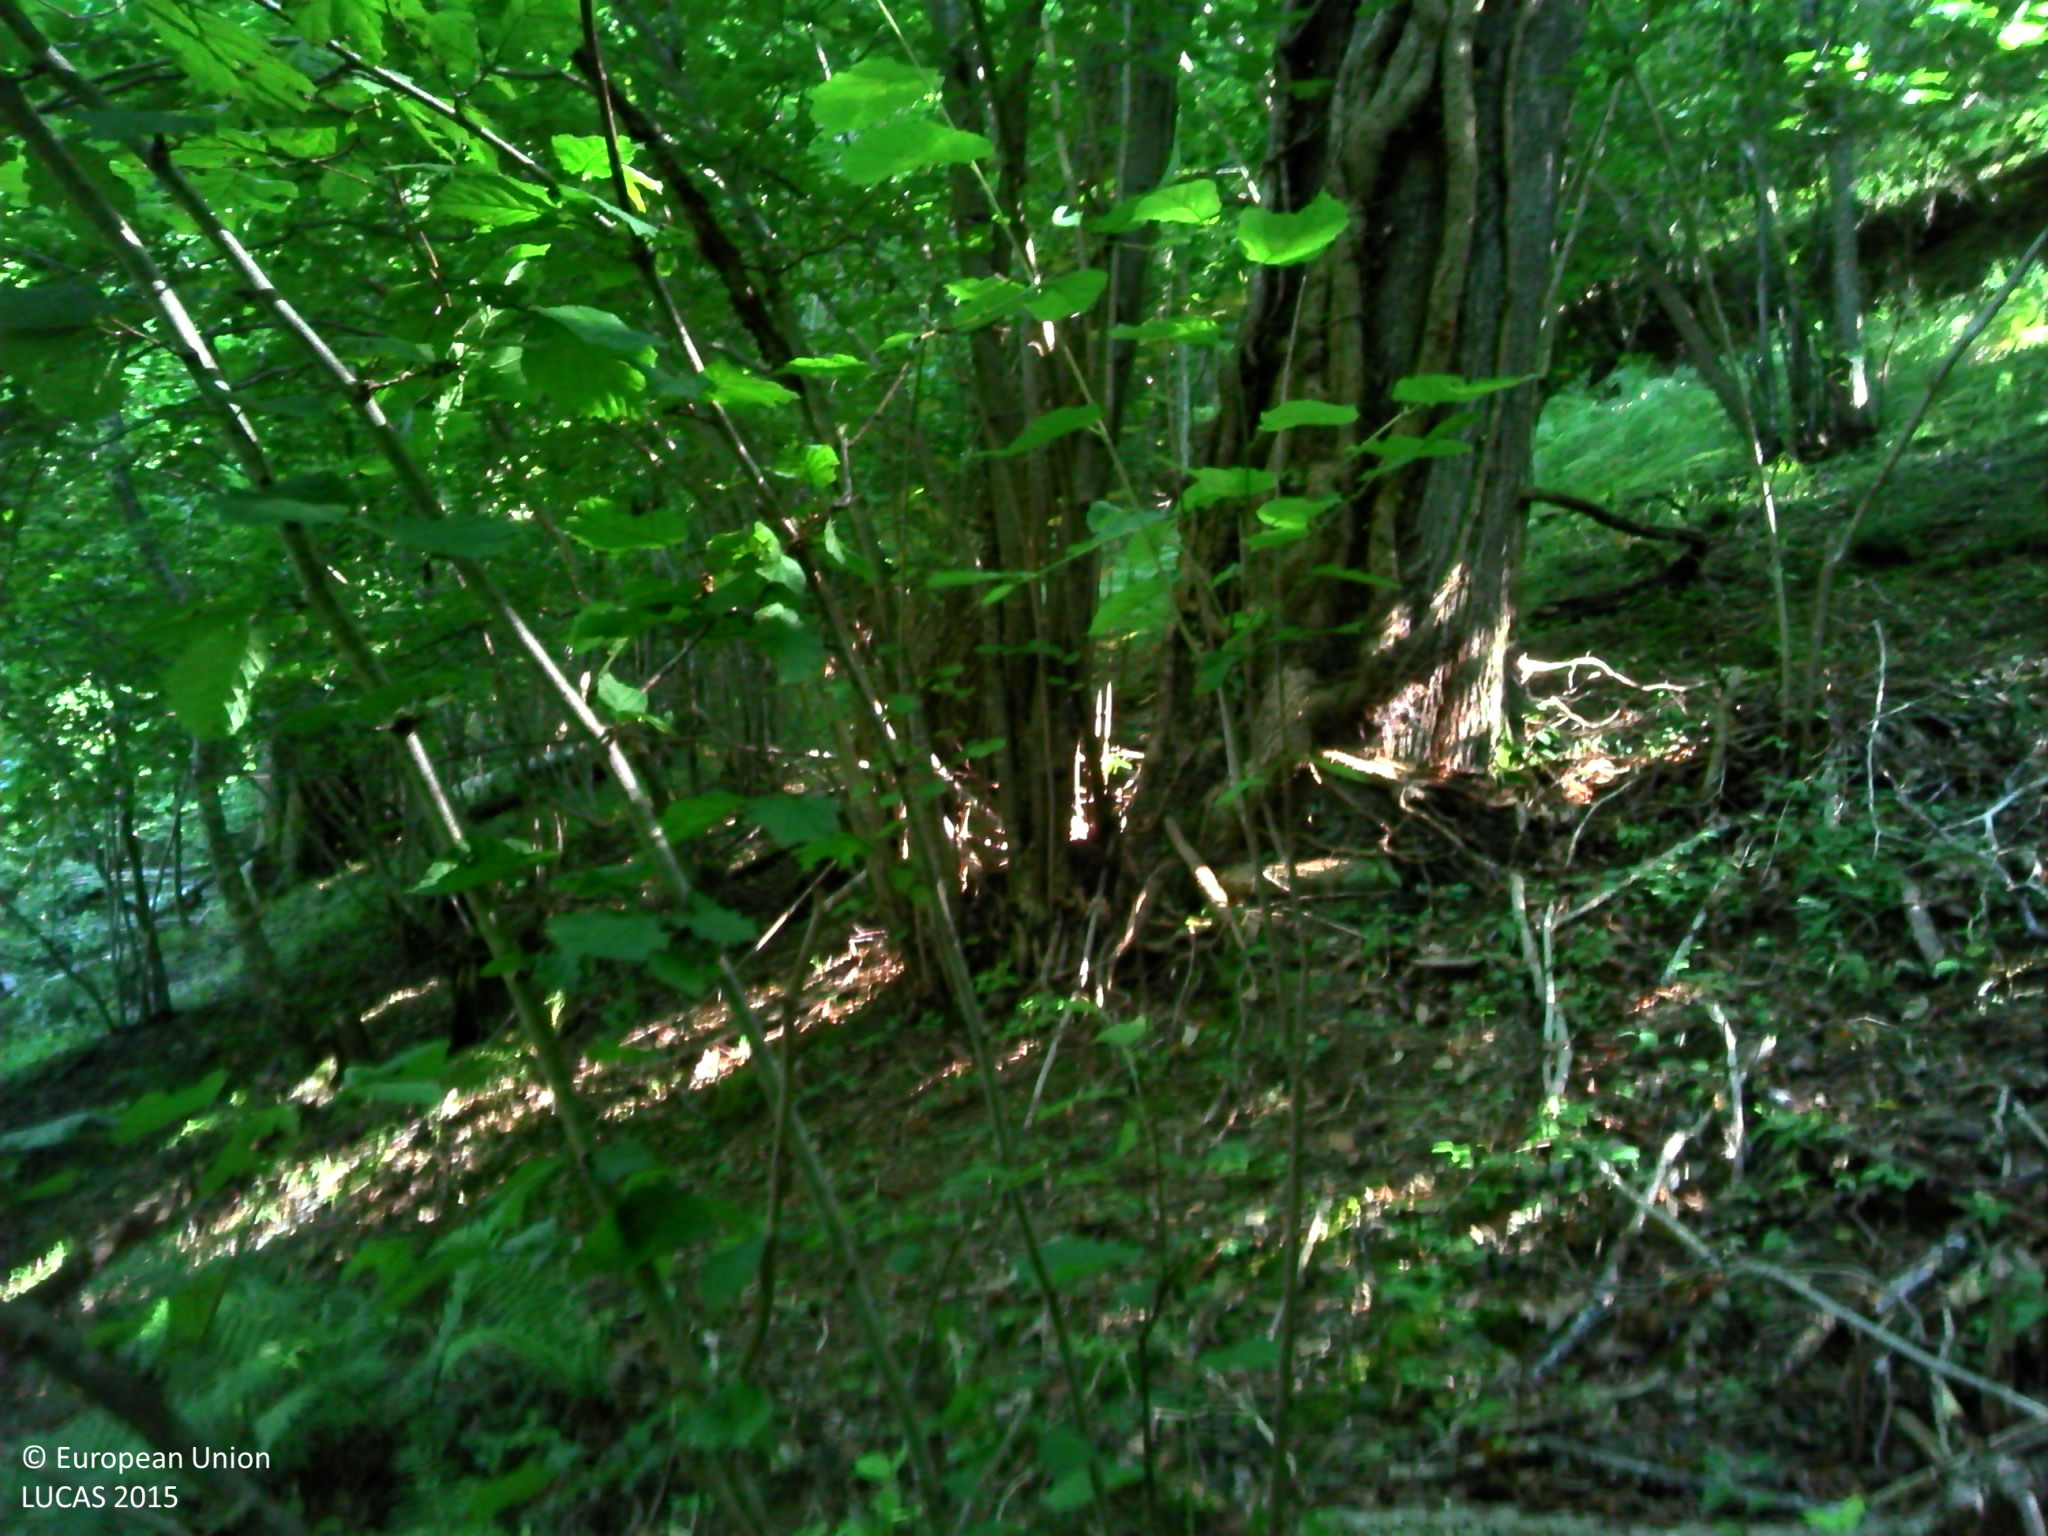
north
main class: Woodland
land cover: Broadleaved woodland
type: mesophytic deciduous forest
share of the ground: > 75 %
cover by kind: broadleaved forest trees 80 %, herbaceous plants 10 %, unconsolidated bare surface 10 %
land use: Semi-natural and natural areas not in use
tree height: > 5 m
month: August
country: FR
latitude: 42.9464
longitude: 1.4639
